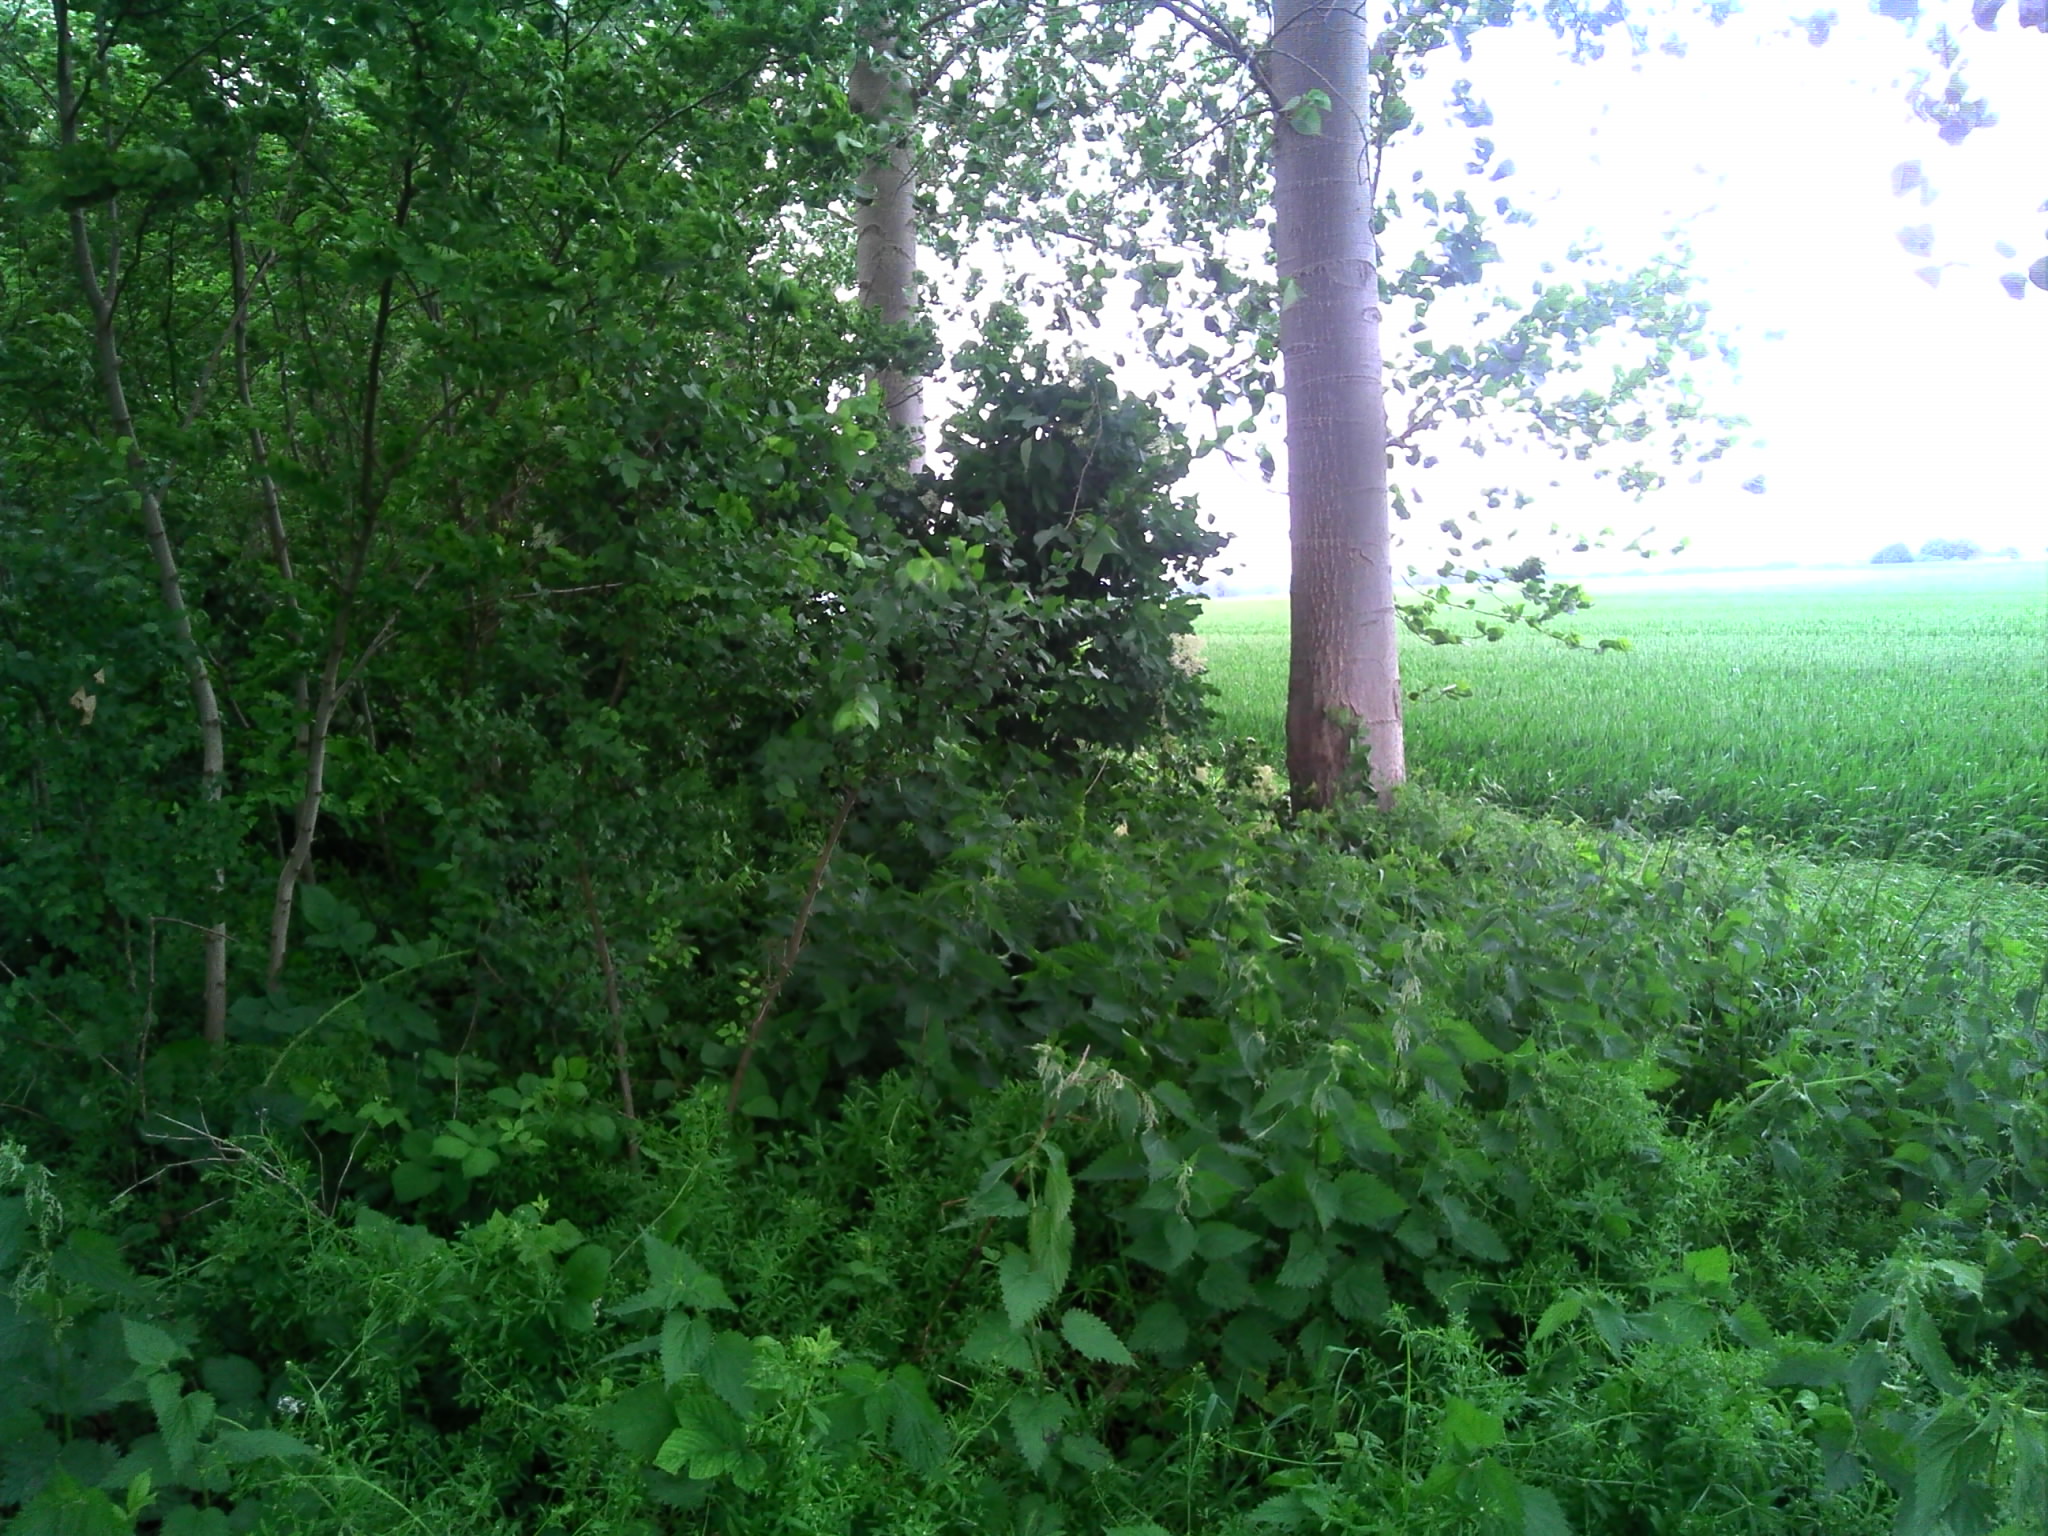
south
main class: Woodland
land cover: Broadleaved woodland
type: exotic forest
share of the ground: > 75 %
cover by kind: broadleaved forest trees 90 %, shrubs 10 %
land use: Forestry
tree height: > 5 m
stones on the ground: < 10 %
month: June
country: FR
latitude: 49.5858
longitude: 3.2276
